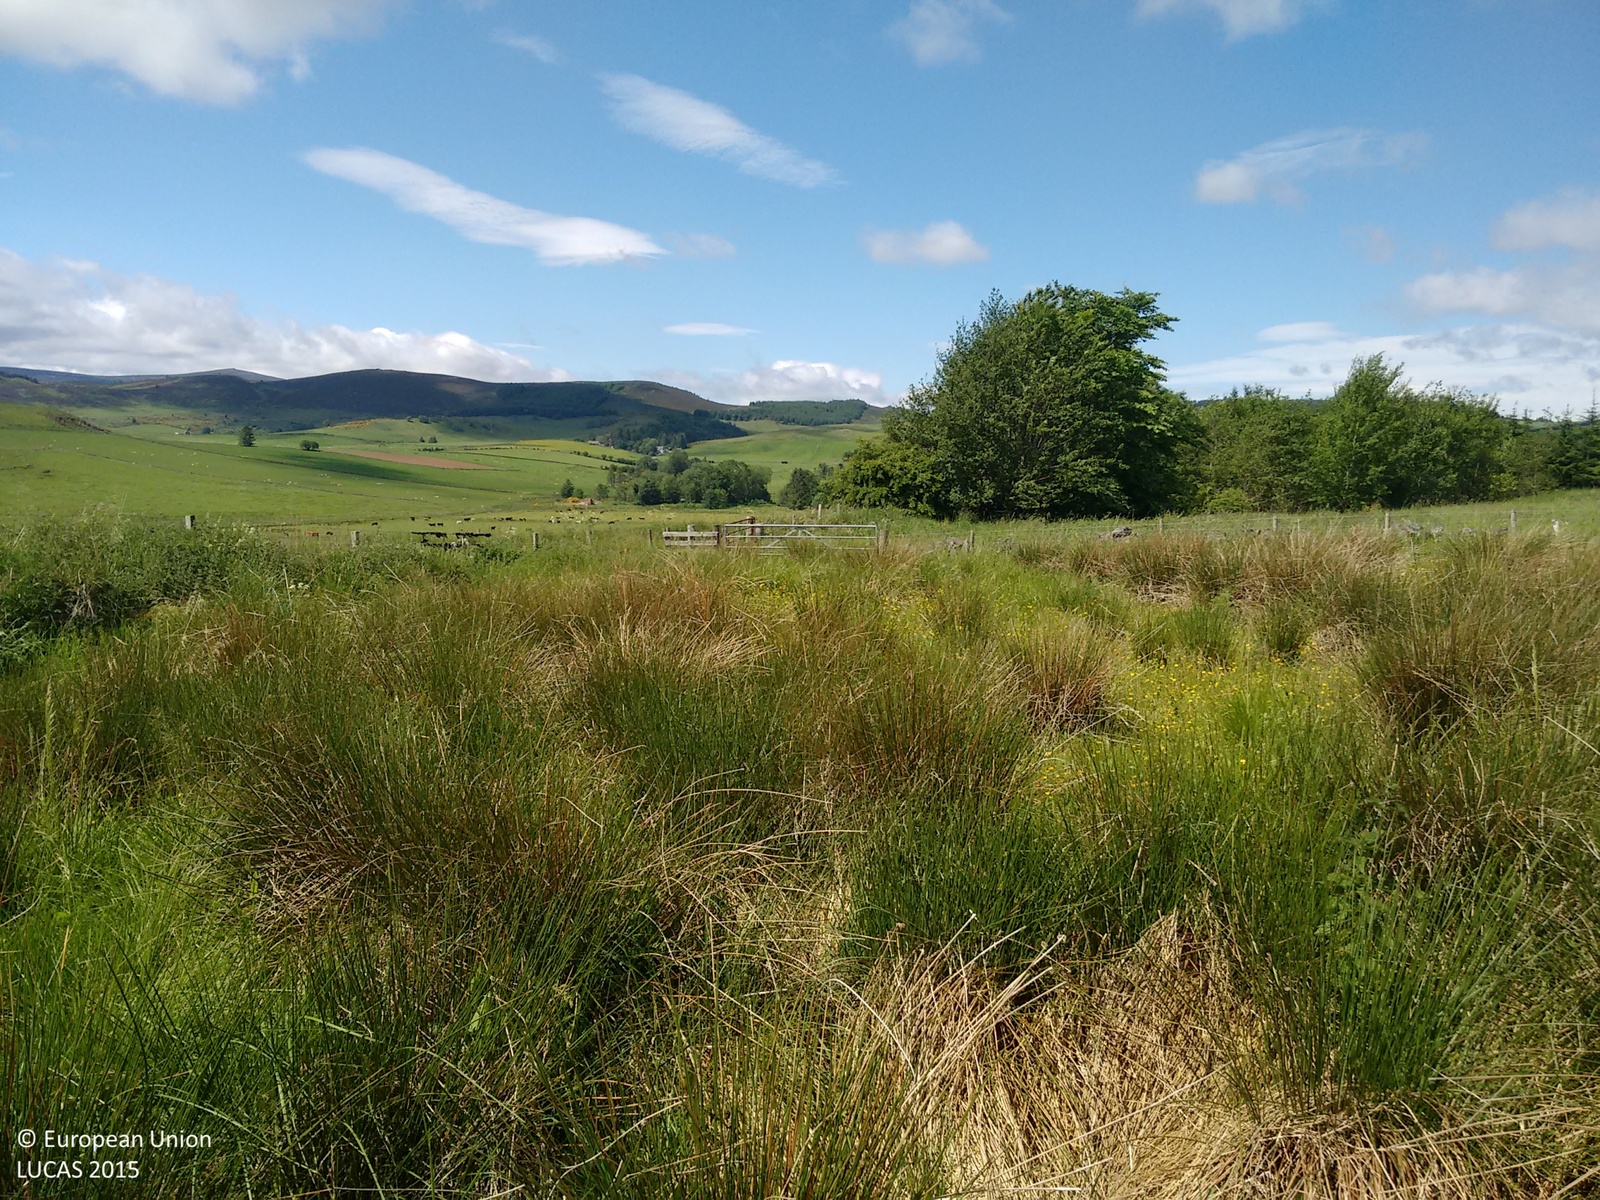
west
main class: Grassland
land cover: Grassland without tree/shrub cover
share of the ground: > 75 %
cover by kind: herbaceous plants 100 %
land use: Agriculture (excluding fallow land and kitchen gardens)
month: June
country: GB
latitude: 57.3419
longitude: -2.8702
